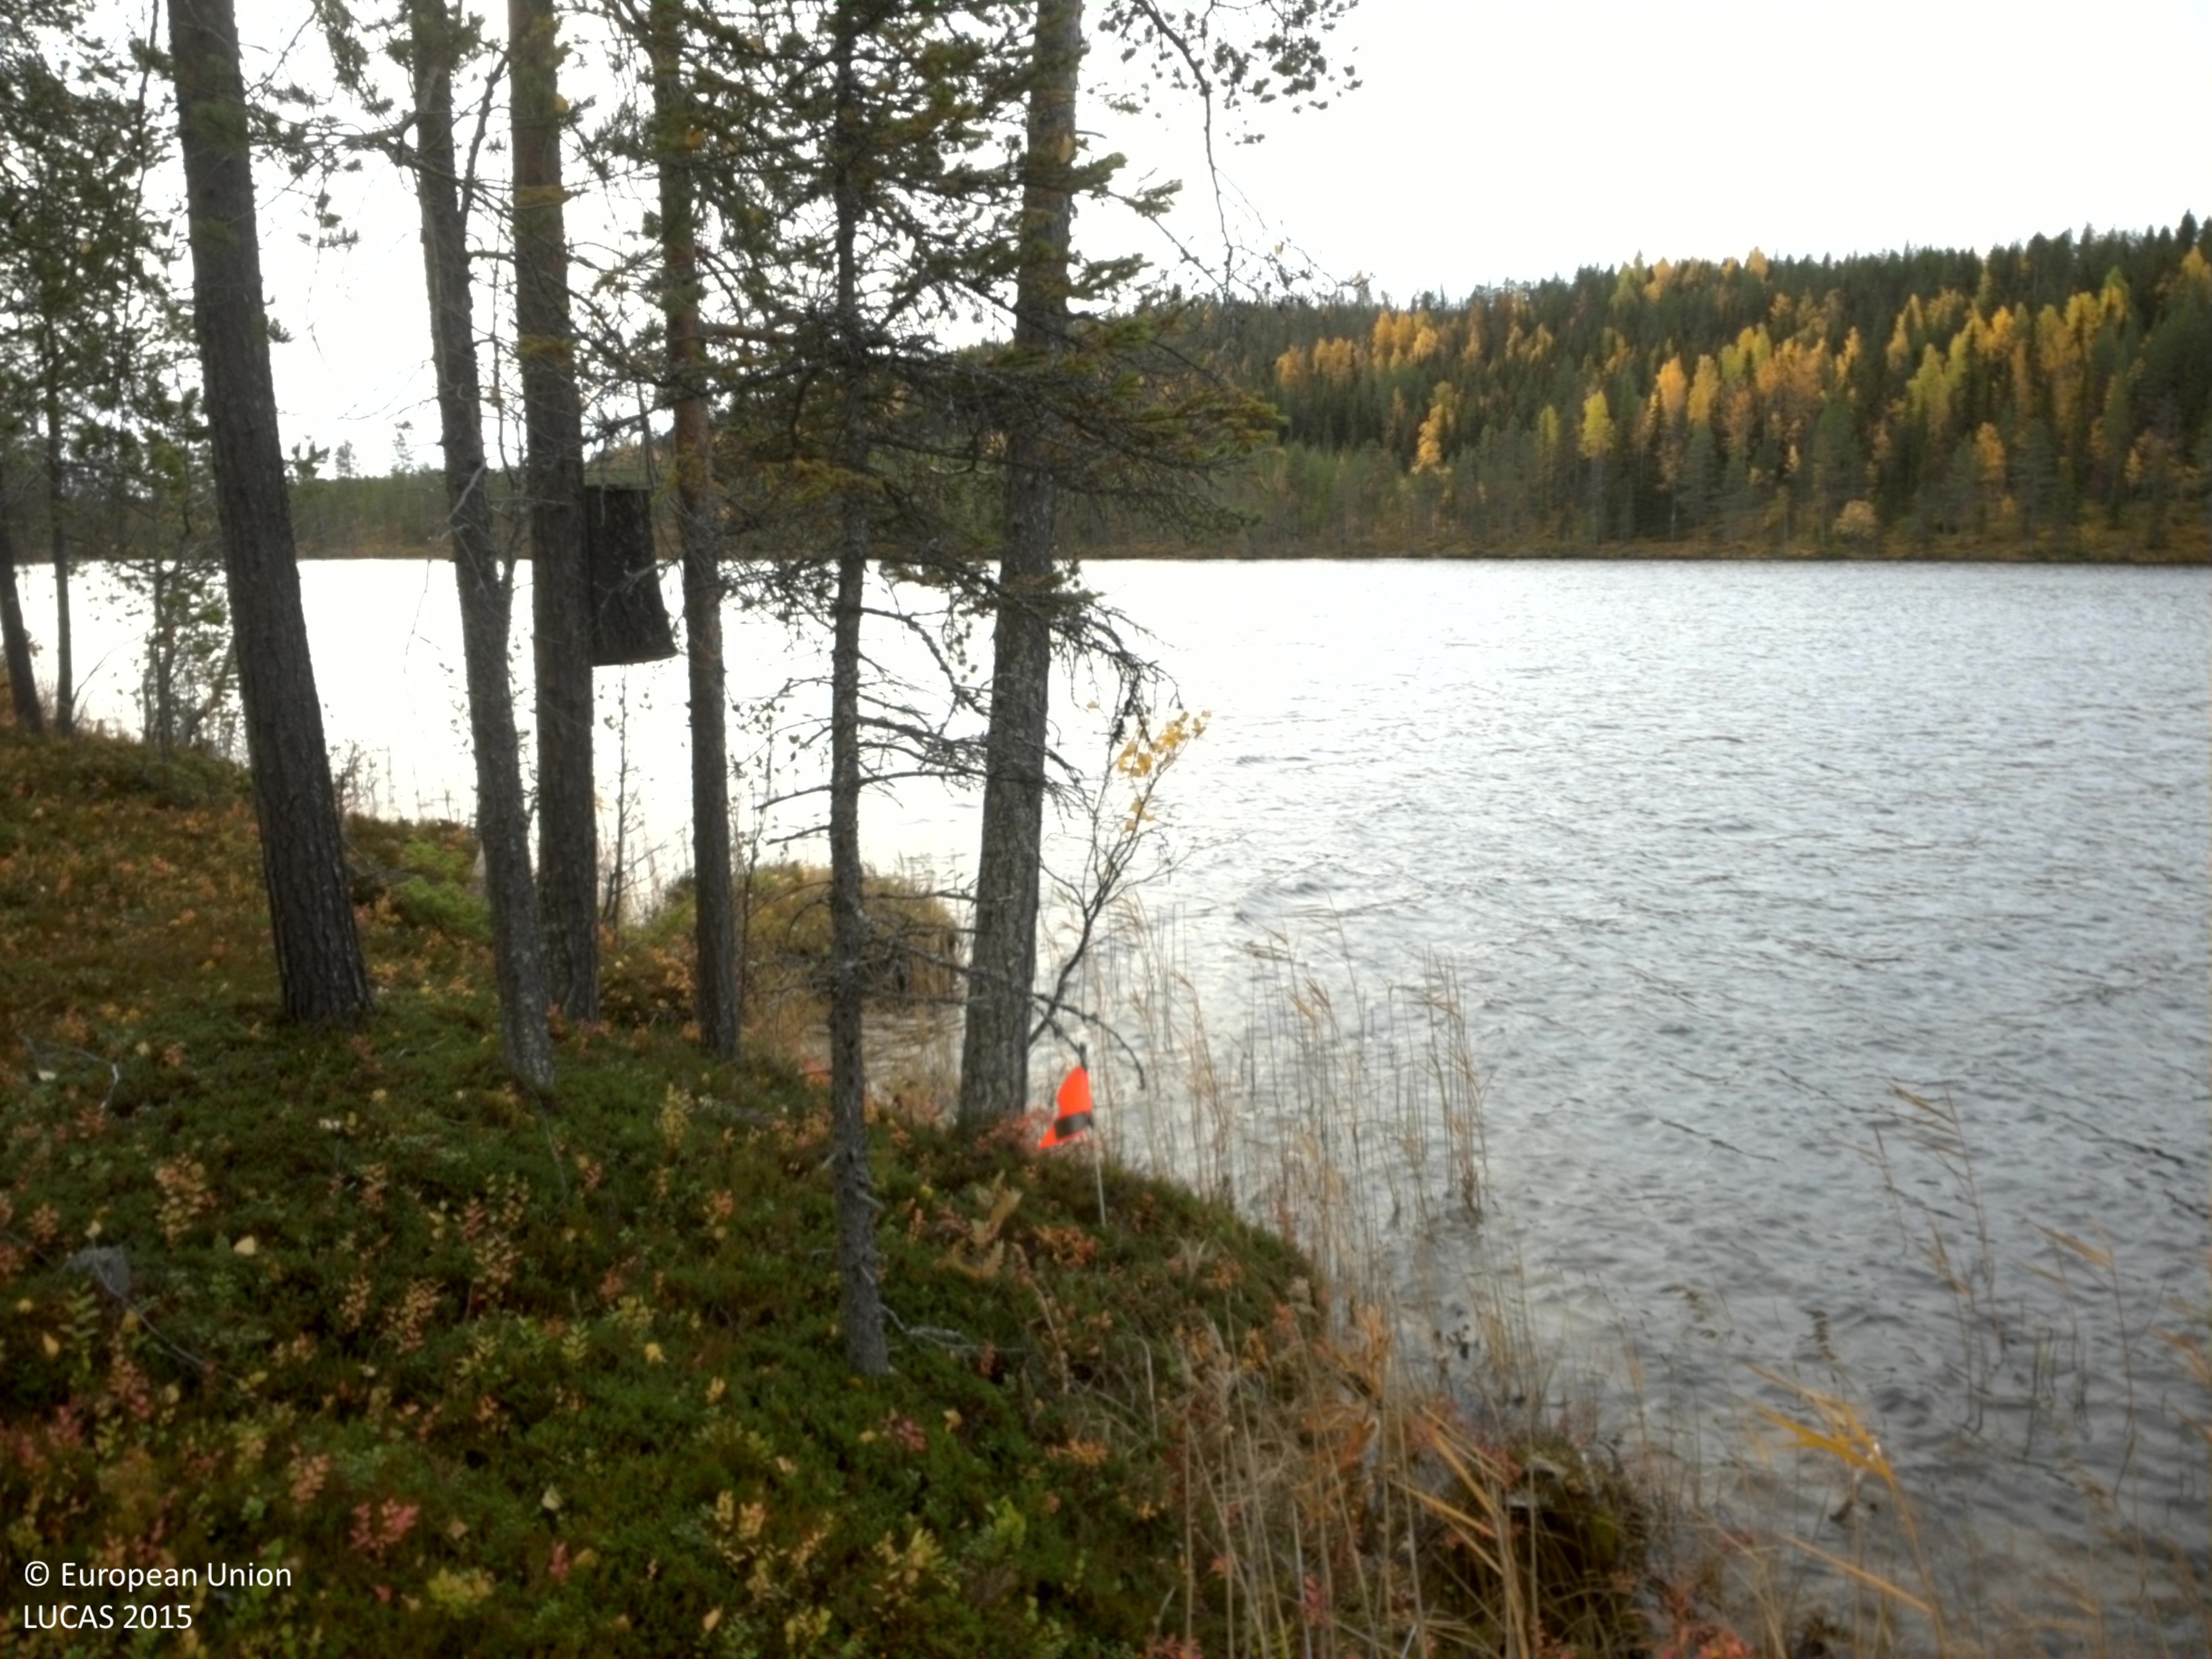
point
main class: Woodland
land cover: Pine dominated coniferous woodland
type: boreal forest
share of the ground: 25 - 50 %
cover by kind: shrubs 45 %, coniferous forest trees 40 %, lichens and mosses 10 %, broadleaved forest trees 5 %
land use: Forestry
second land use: Residential
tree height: > 5 m
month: October
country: SE
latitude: 65.0576
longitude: 17.4653
